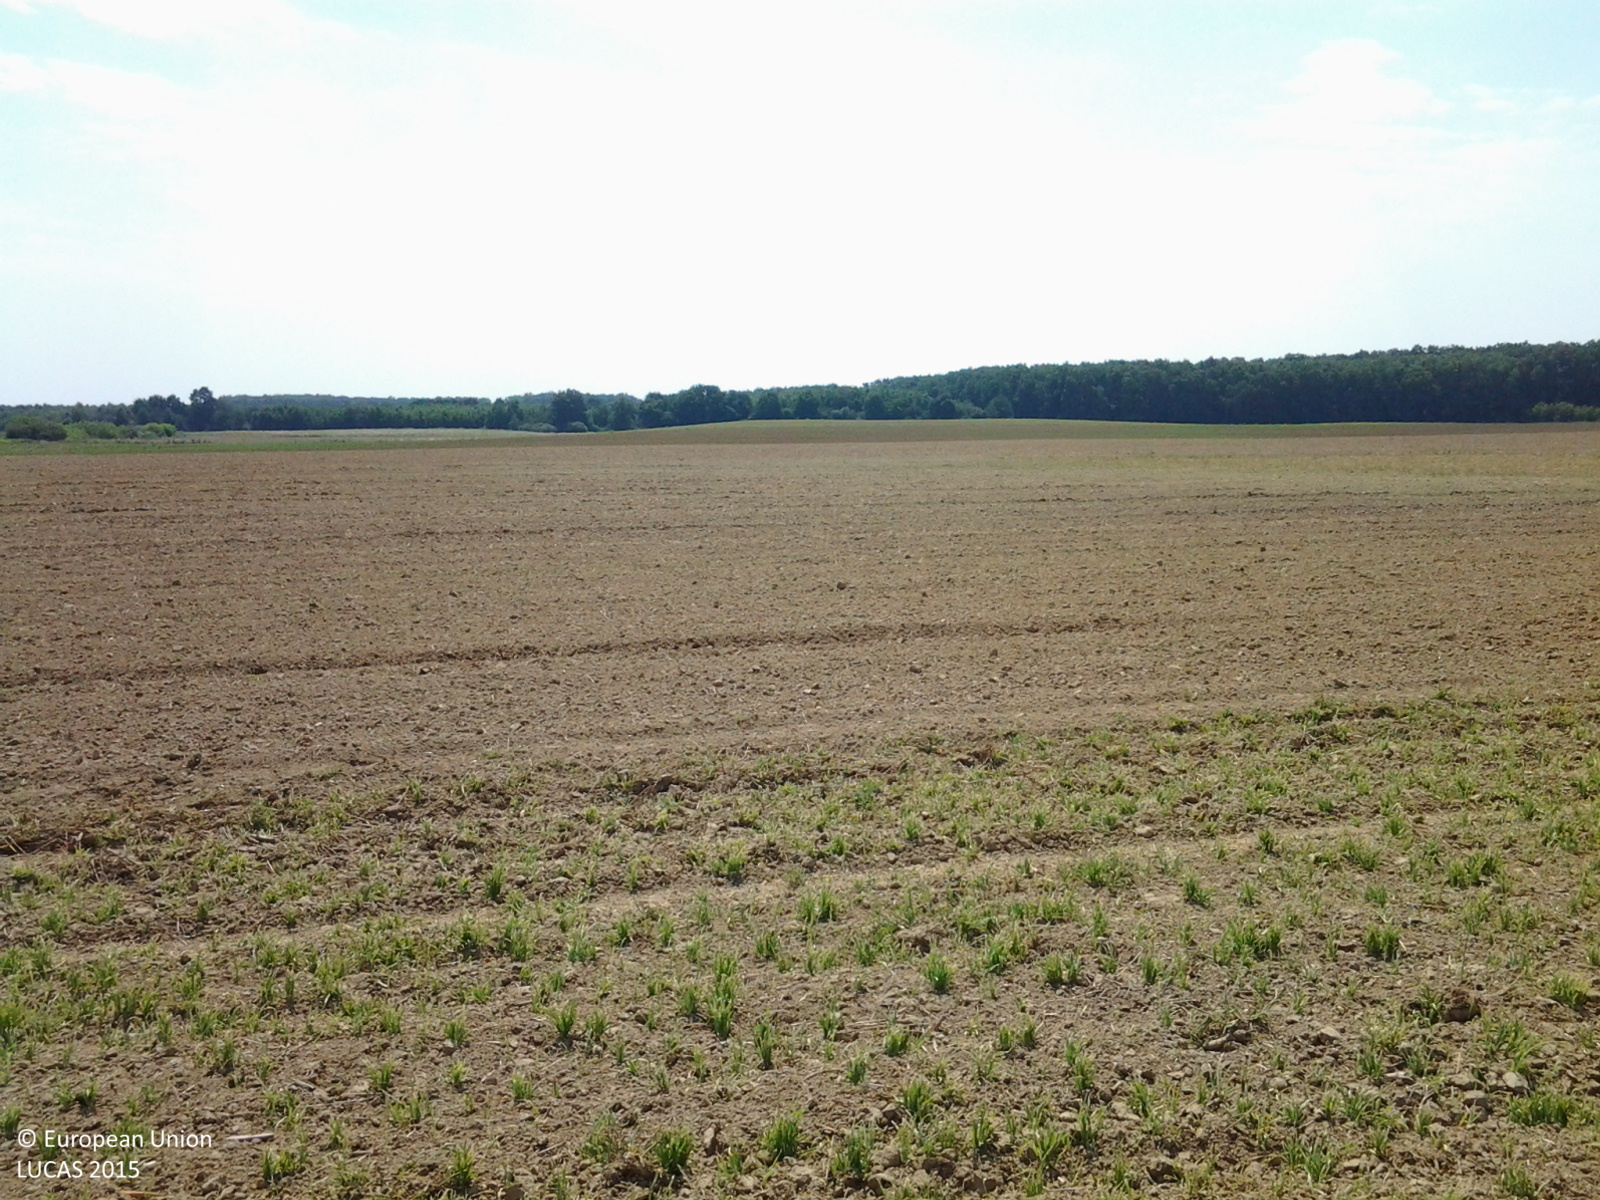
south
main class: Cropland
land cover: Common wheat
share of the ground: < 10 %
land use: Agriculture (excluding fallow land and kitchen gardens)
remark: Harvested field
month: August
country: HU
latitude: 46.1384
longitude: 17.2908
